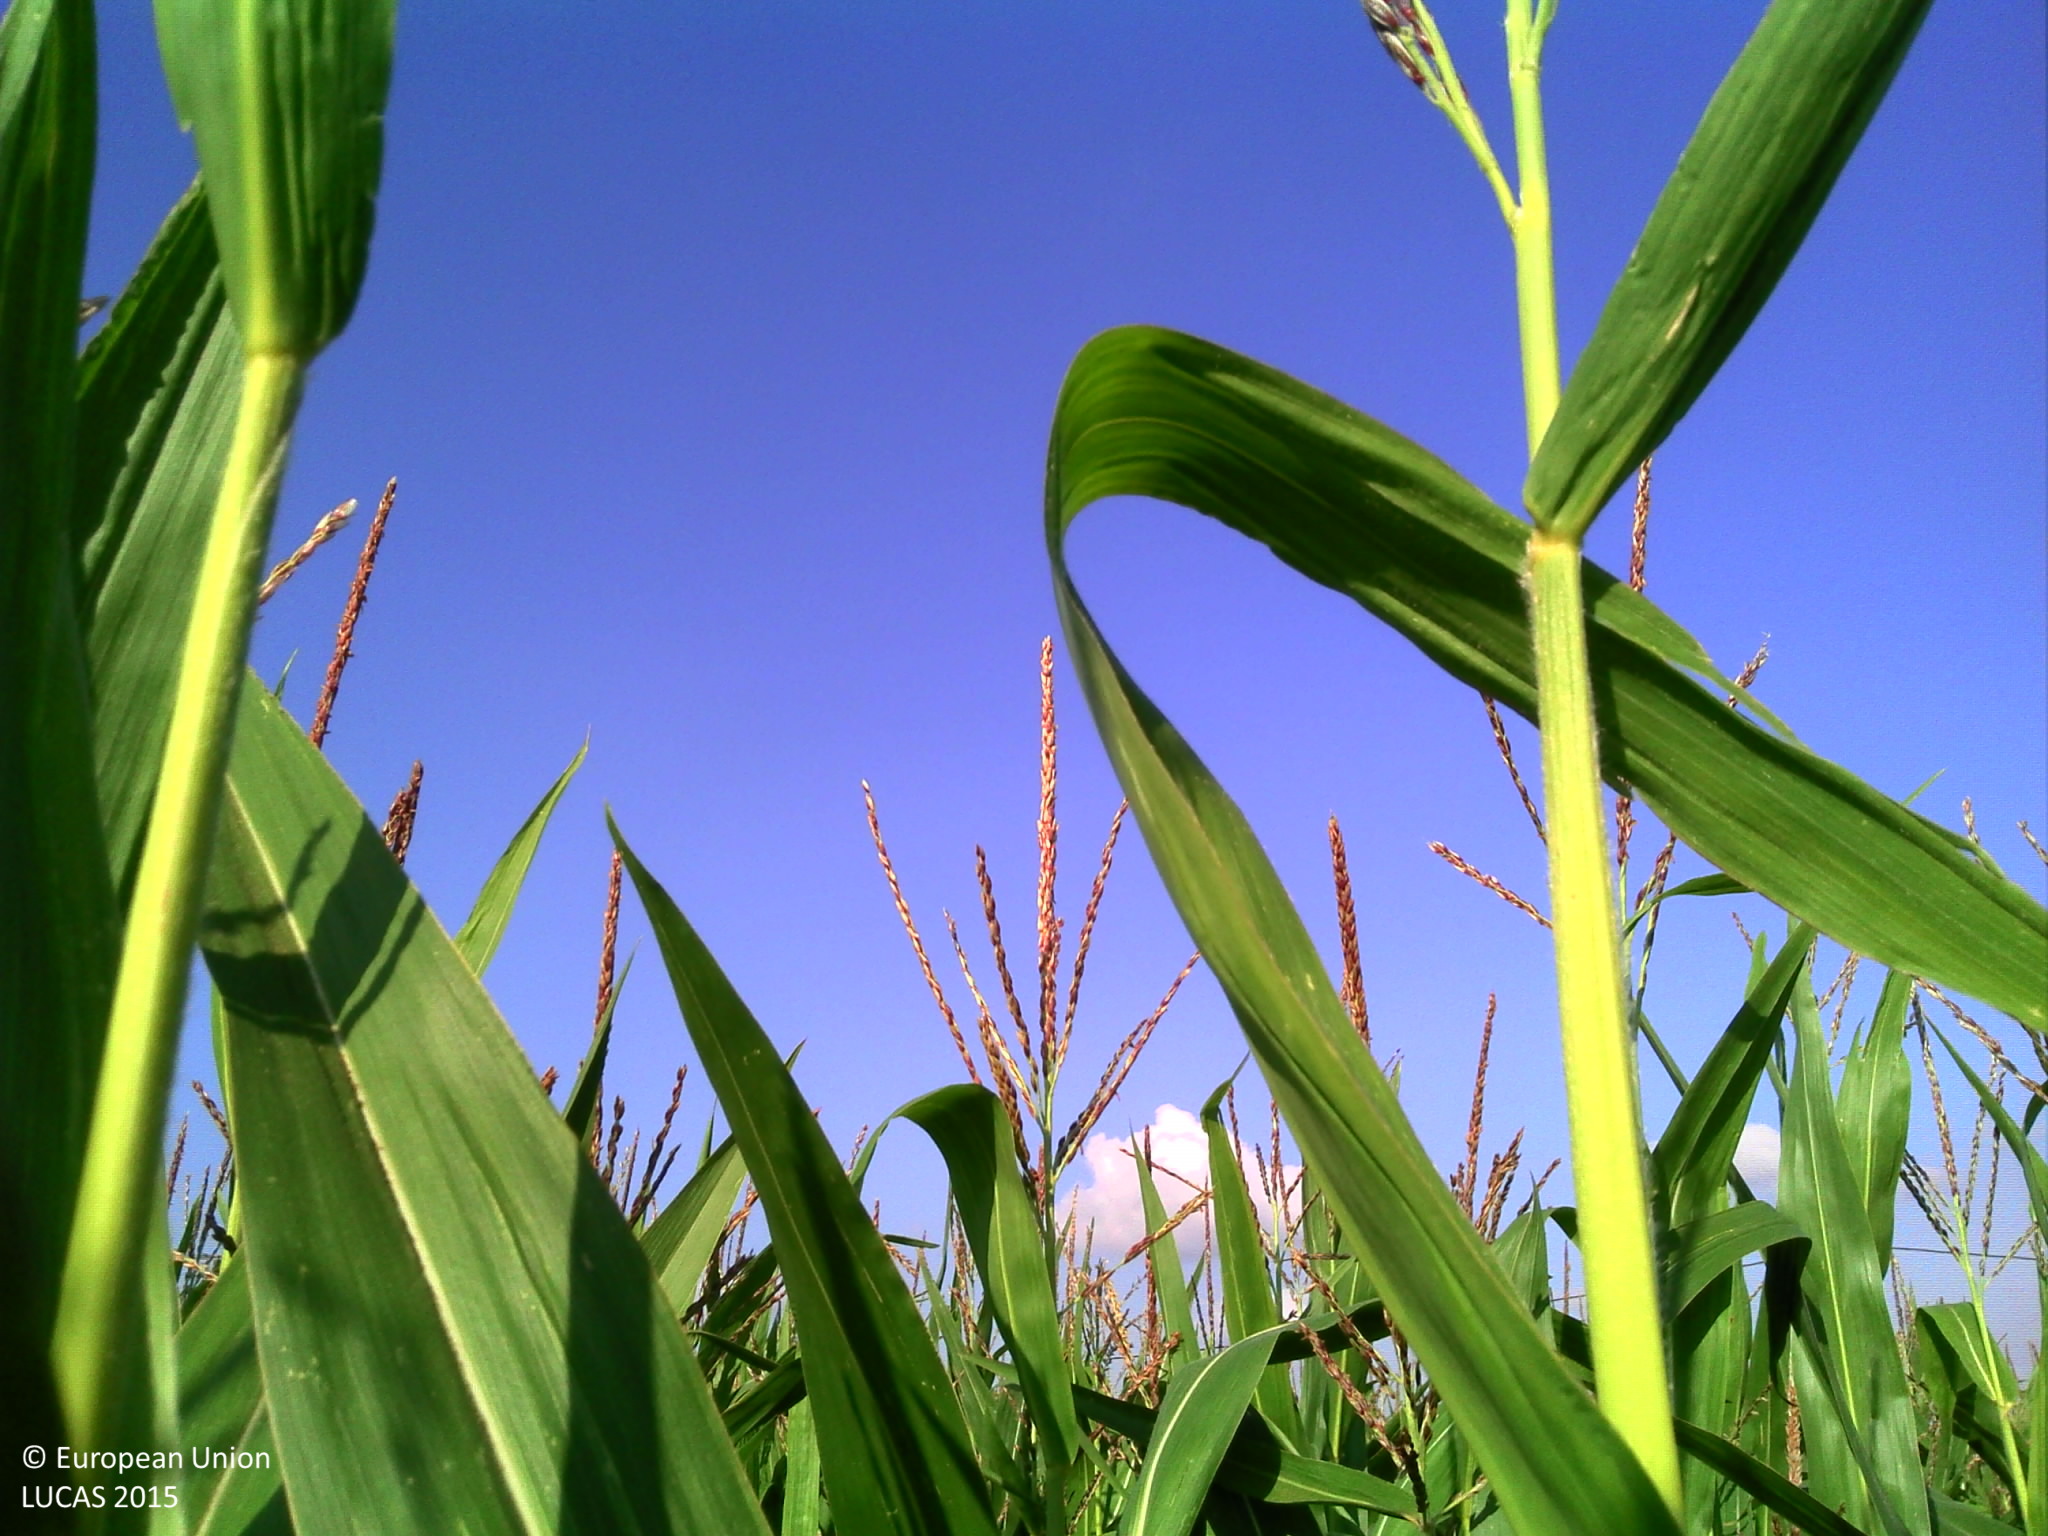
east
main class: Cropland
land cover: Maize
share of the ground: > 75 %
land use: Agriculture (excluding fallow land and kitchen gardens)
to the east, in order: Maize; Abandoned hedges; Electric lines; Ditches and canals; Grass margins; Tracks; Grass margins; Ditches and canals; Grass margins; Common wheat; Grass margins; Single bushes/trees; Maize; Grass margins; Common wheat
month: August
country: FR
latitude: 48.3155
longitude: -1.9599
